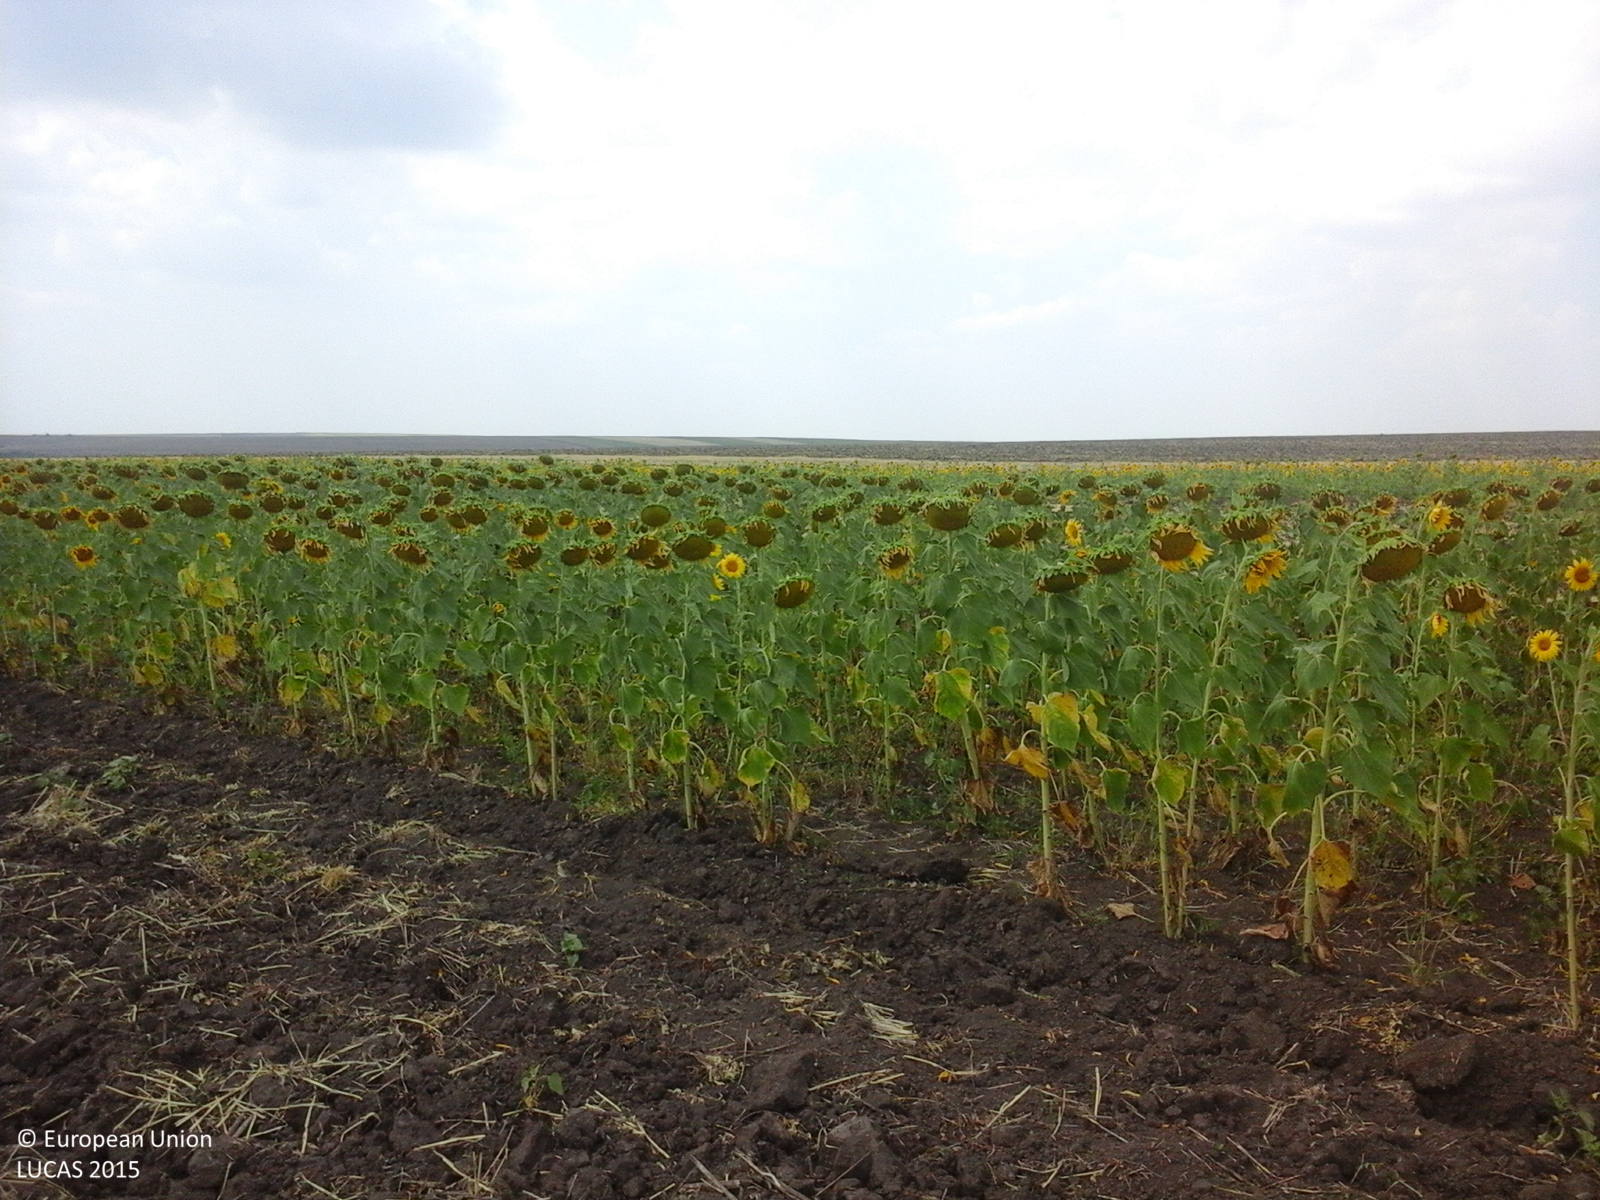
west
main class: Cropland
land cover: Common wheat
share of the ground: 10 - 25 %
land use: Agriculture (excluding fallow land and kitchen gardens)
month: July
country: RO
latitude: 46.0614
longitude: 28.0004
